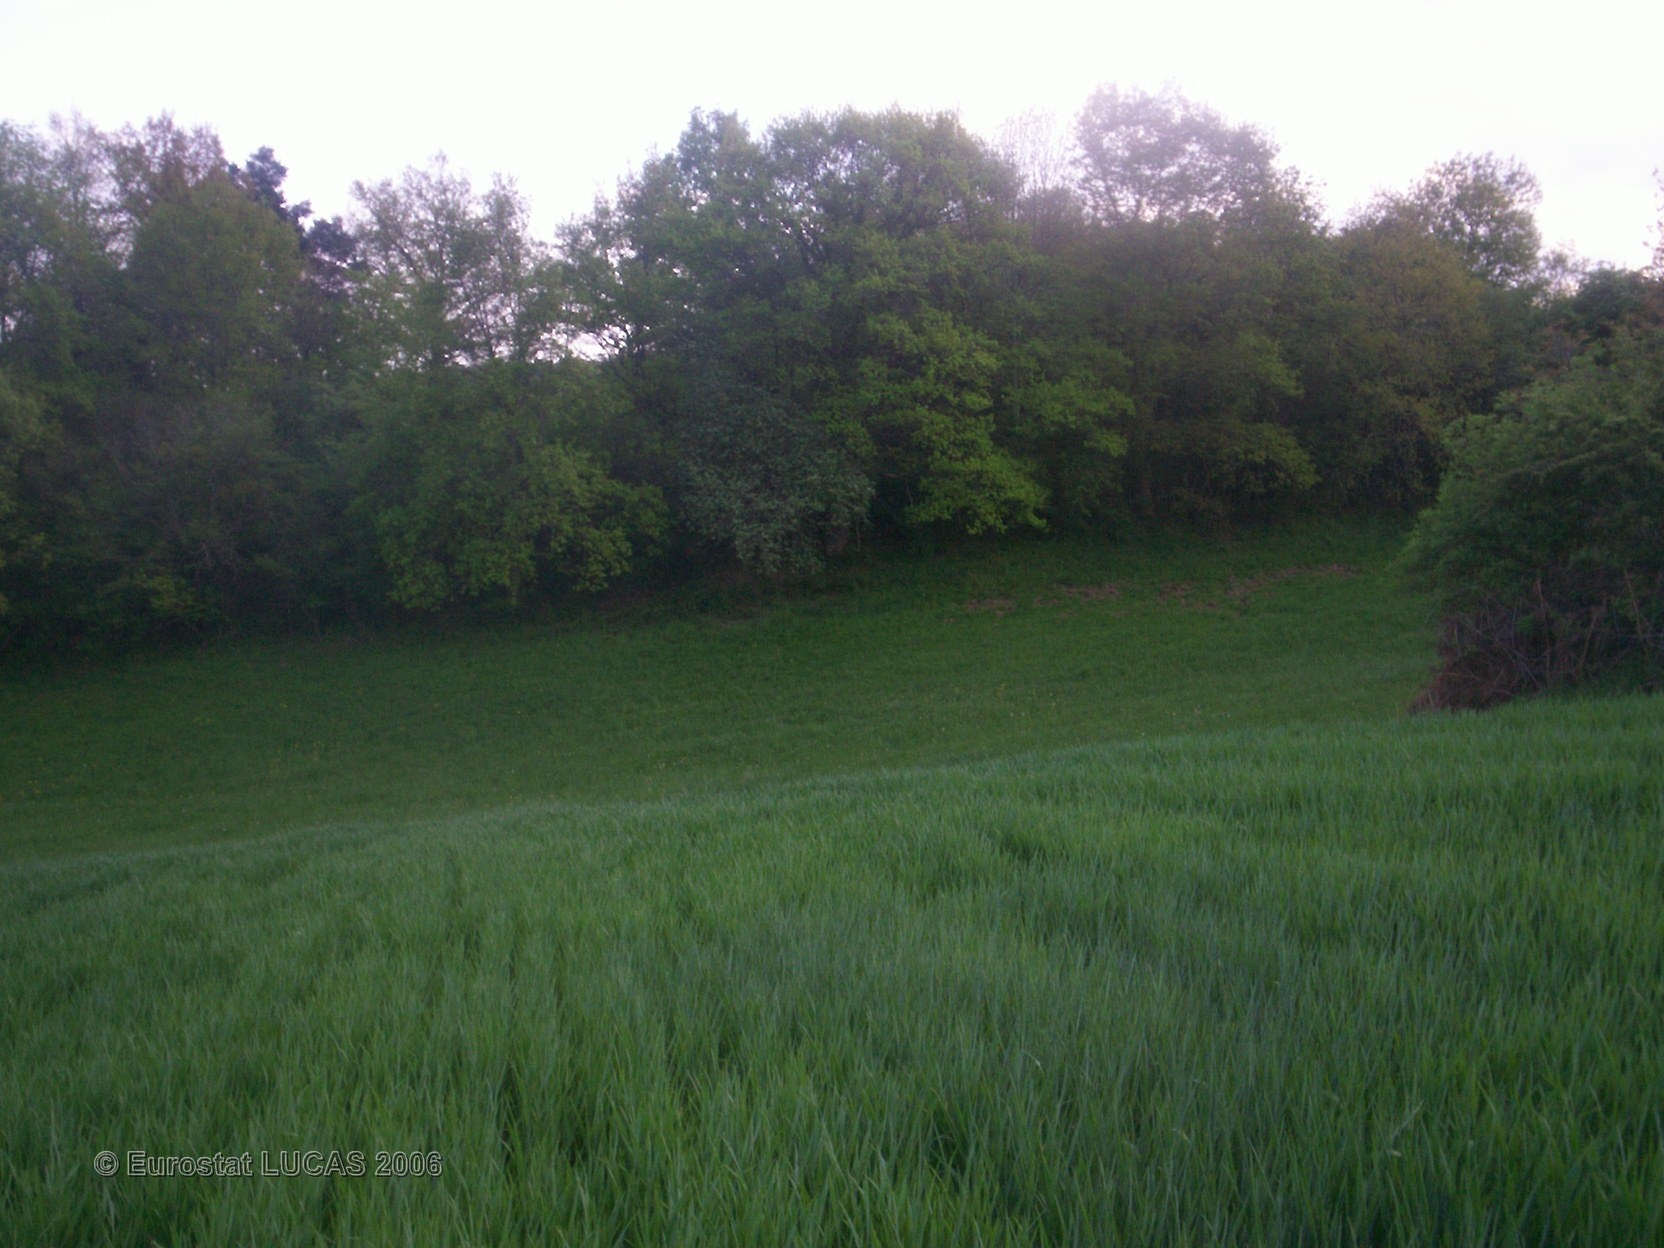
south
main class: Cropland
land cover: Common wheat
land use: Agriculture (excluding fallow land and kitchen gardens)
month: May
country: FR
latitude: 46.0174
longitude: 3.0627
